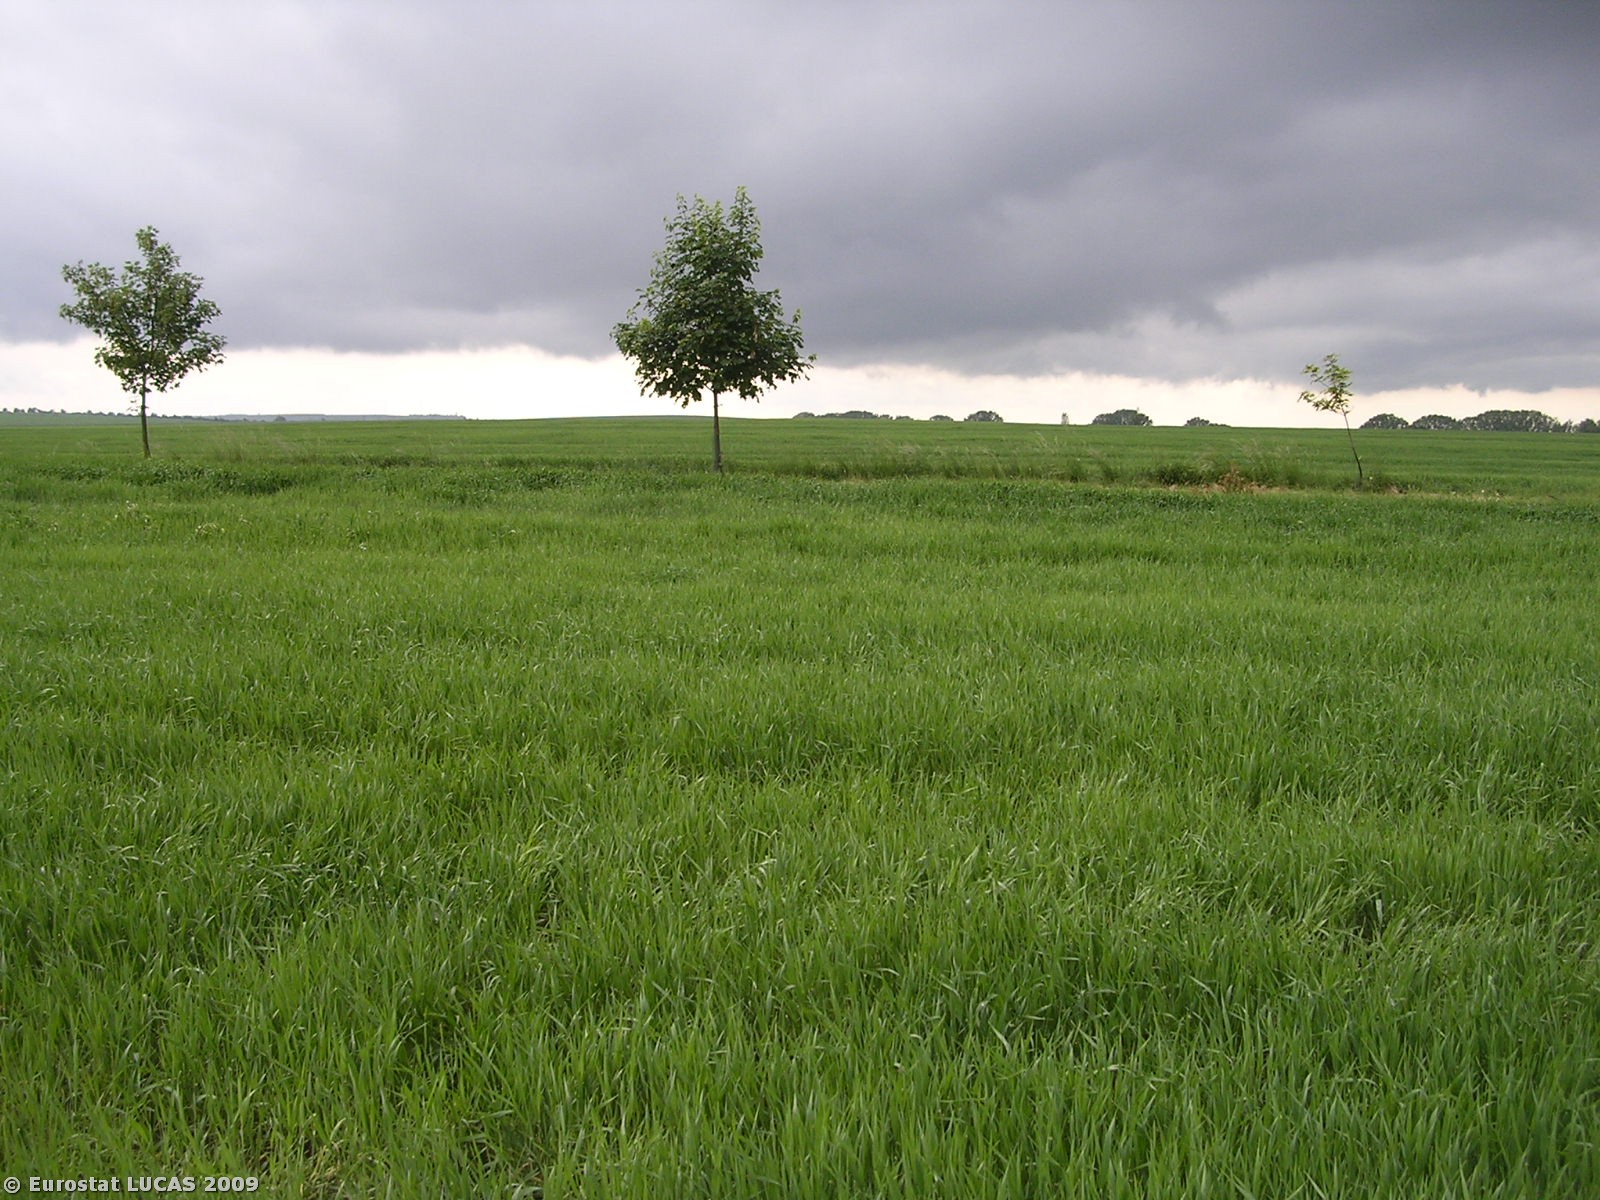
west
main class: Cropland
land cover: Barley
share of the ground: > 75 %
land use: Agriculture (excluding fallow land and kitchen gardens)
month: May
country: CZ
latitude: 50.2681
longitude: 14.2242
